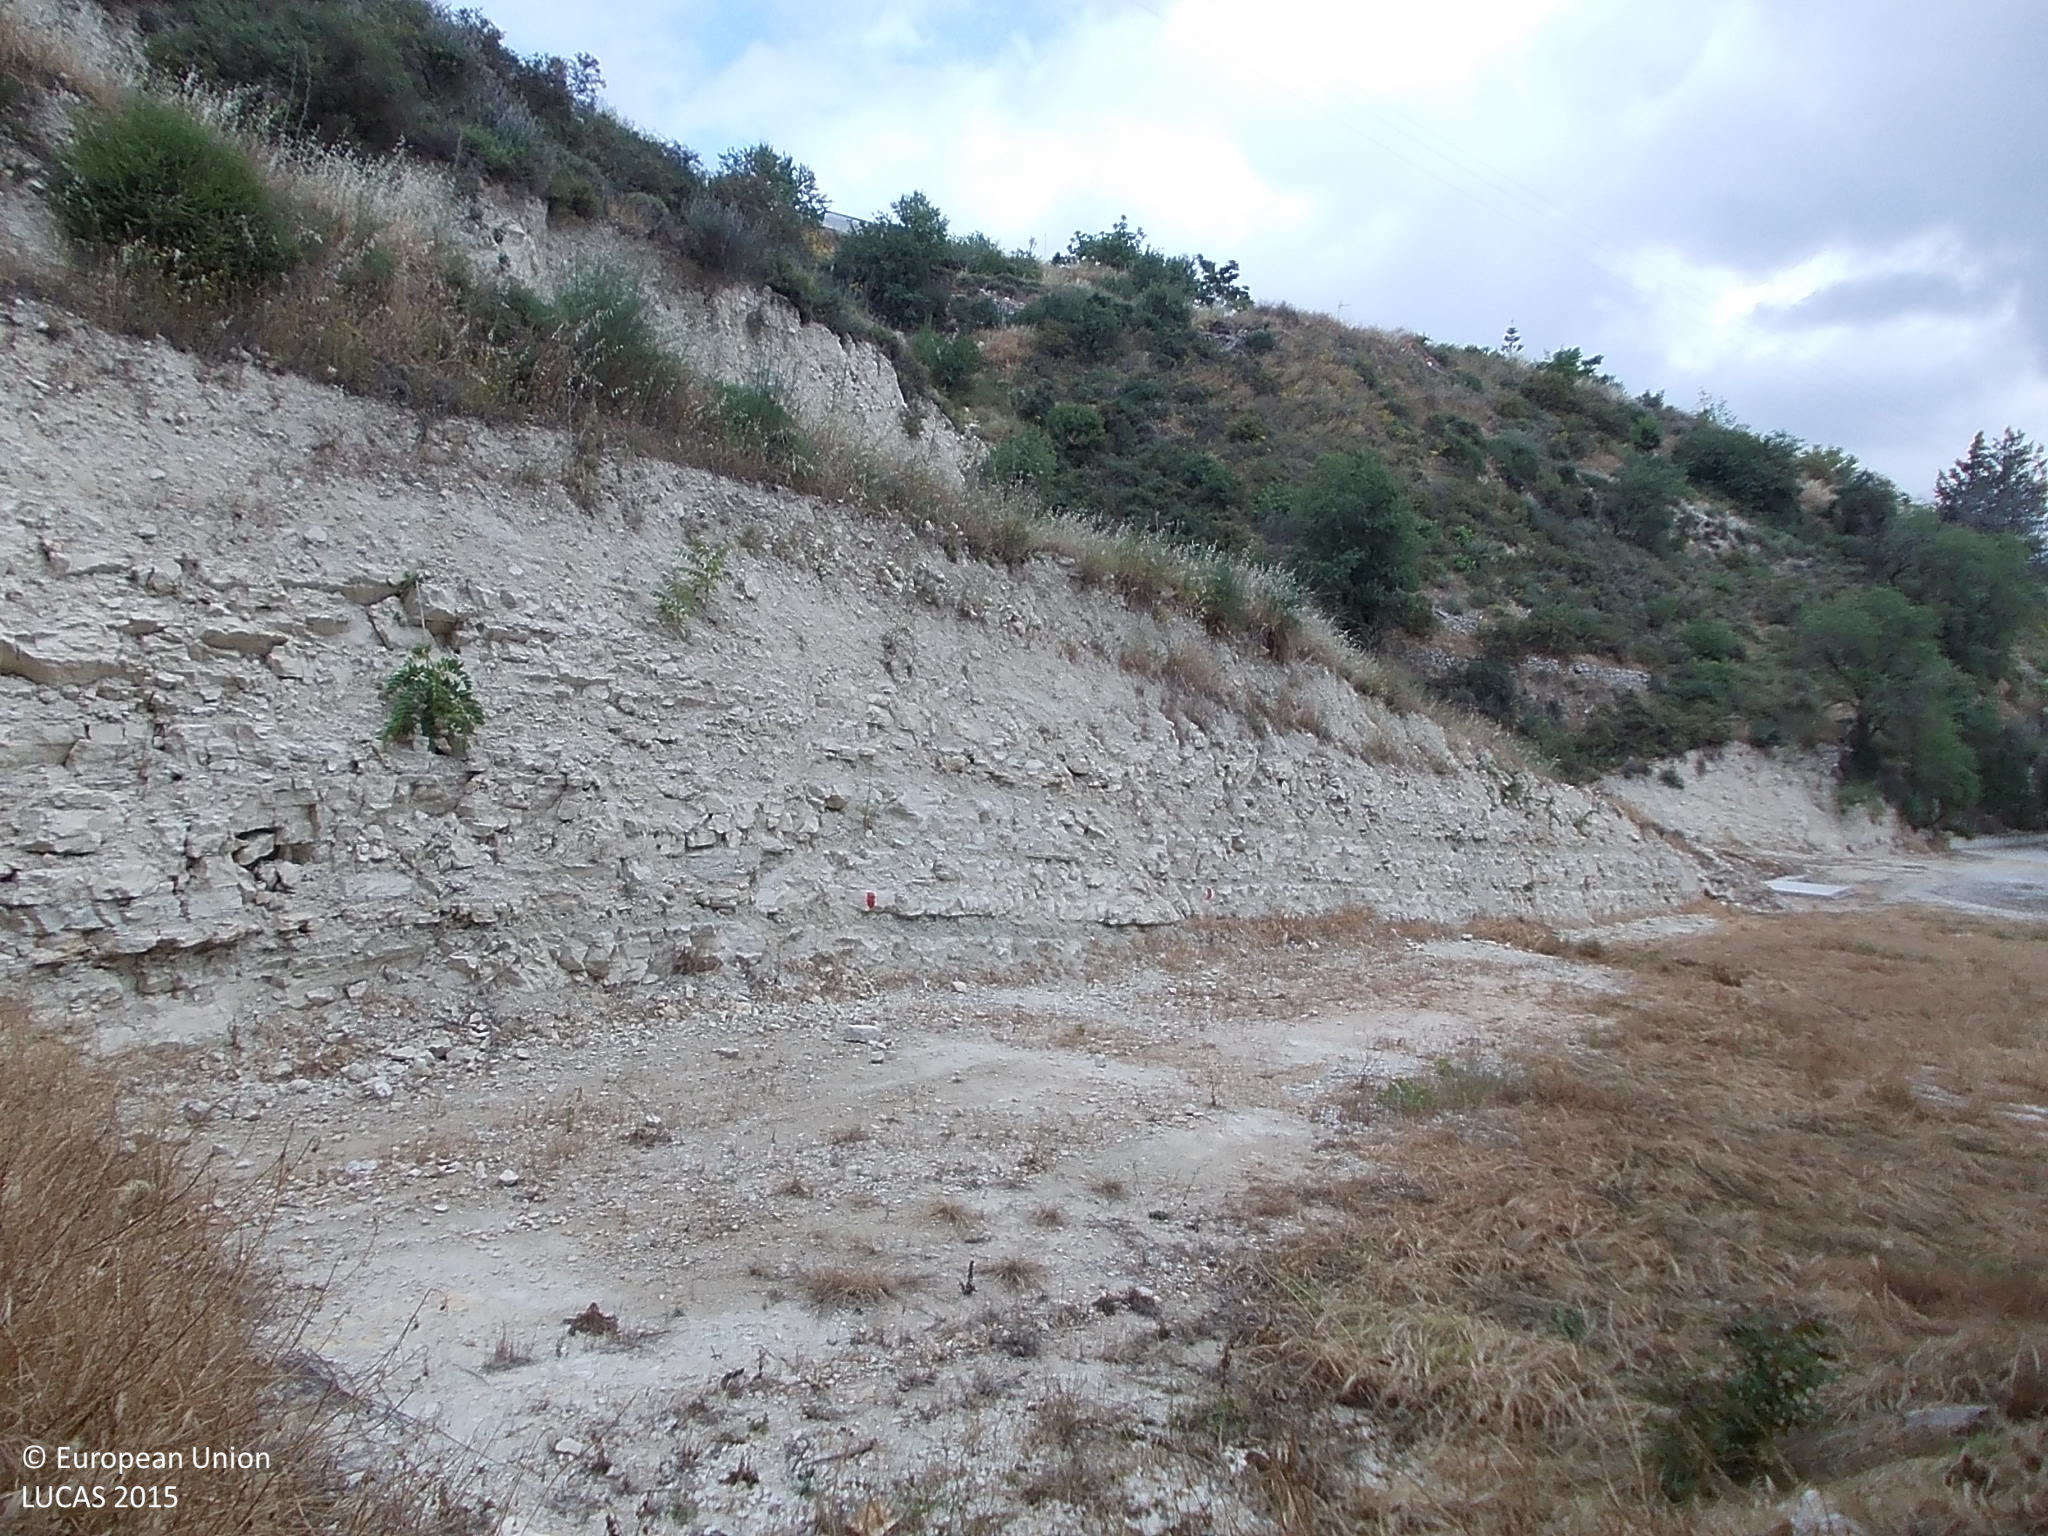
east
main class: Woodland
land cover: Broadleaved woodland
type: broadleaved evergreen forest
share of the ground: 10 - 25 %
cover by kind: shrubs 65 %, broadleaved forest trees 15 %, herbaceous plants 10 %, unconsolidated bare surface 10 %
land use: Semi-natural and natural areas not in use
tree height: > 5 m
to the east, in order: Broadleaved woodland; Grassland without tree/shrub cover; Other bare soil; Shrubland with sparse tree cover; Electric lines; Shrubland with sparse tree cover; Electric lines; Shrubland with sparse tree cover; Artificial constructions in urban areas
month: May
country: CY
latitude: 34.8252
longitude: 32.8039
